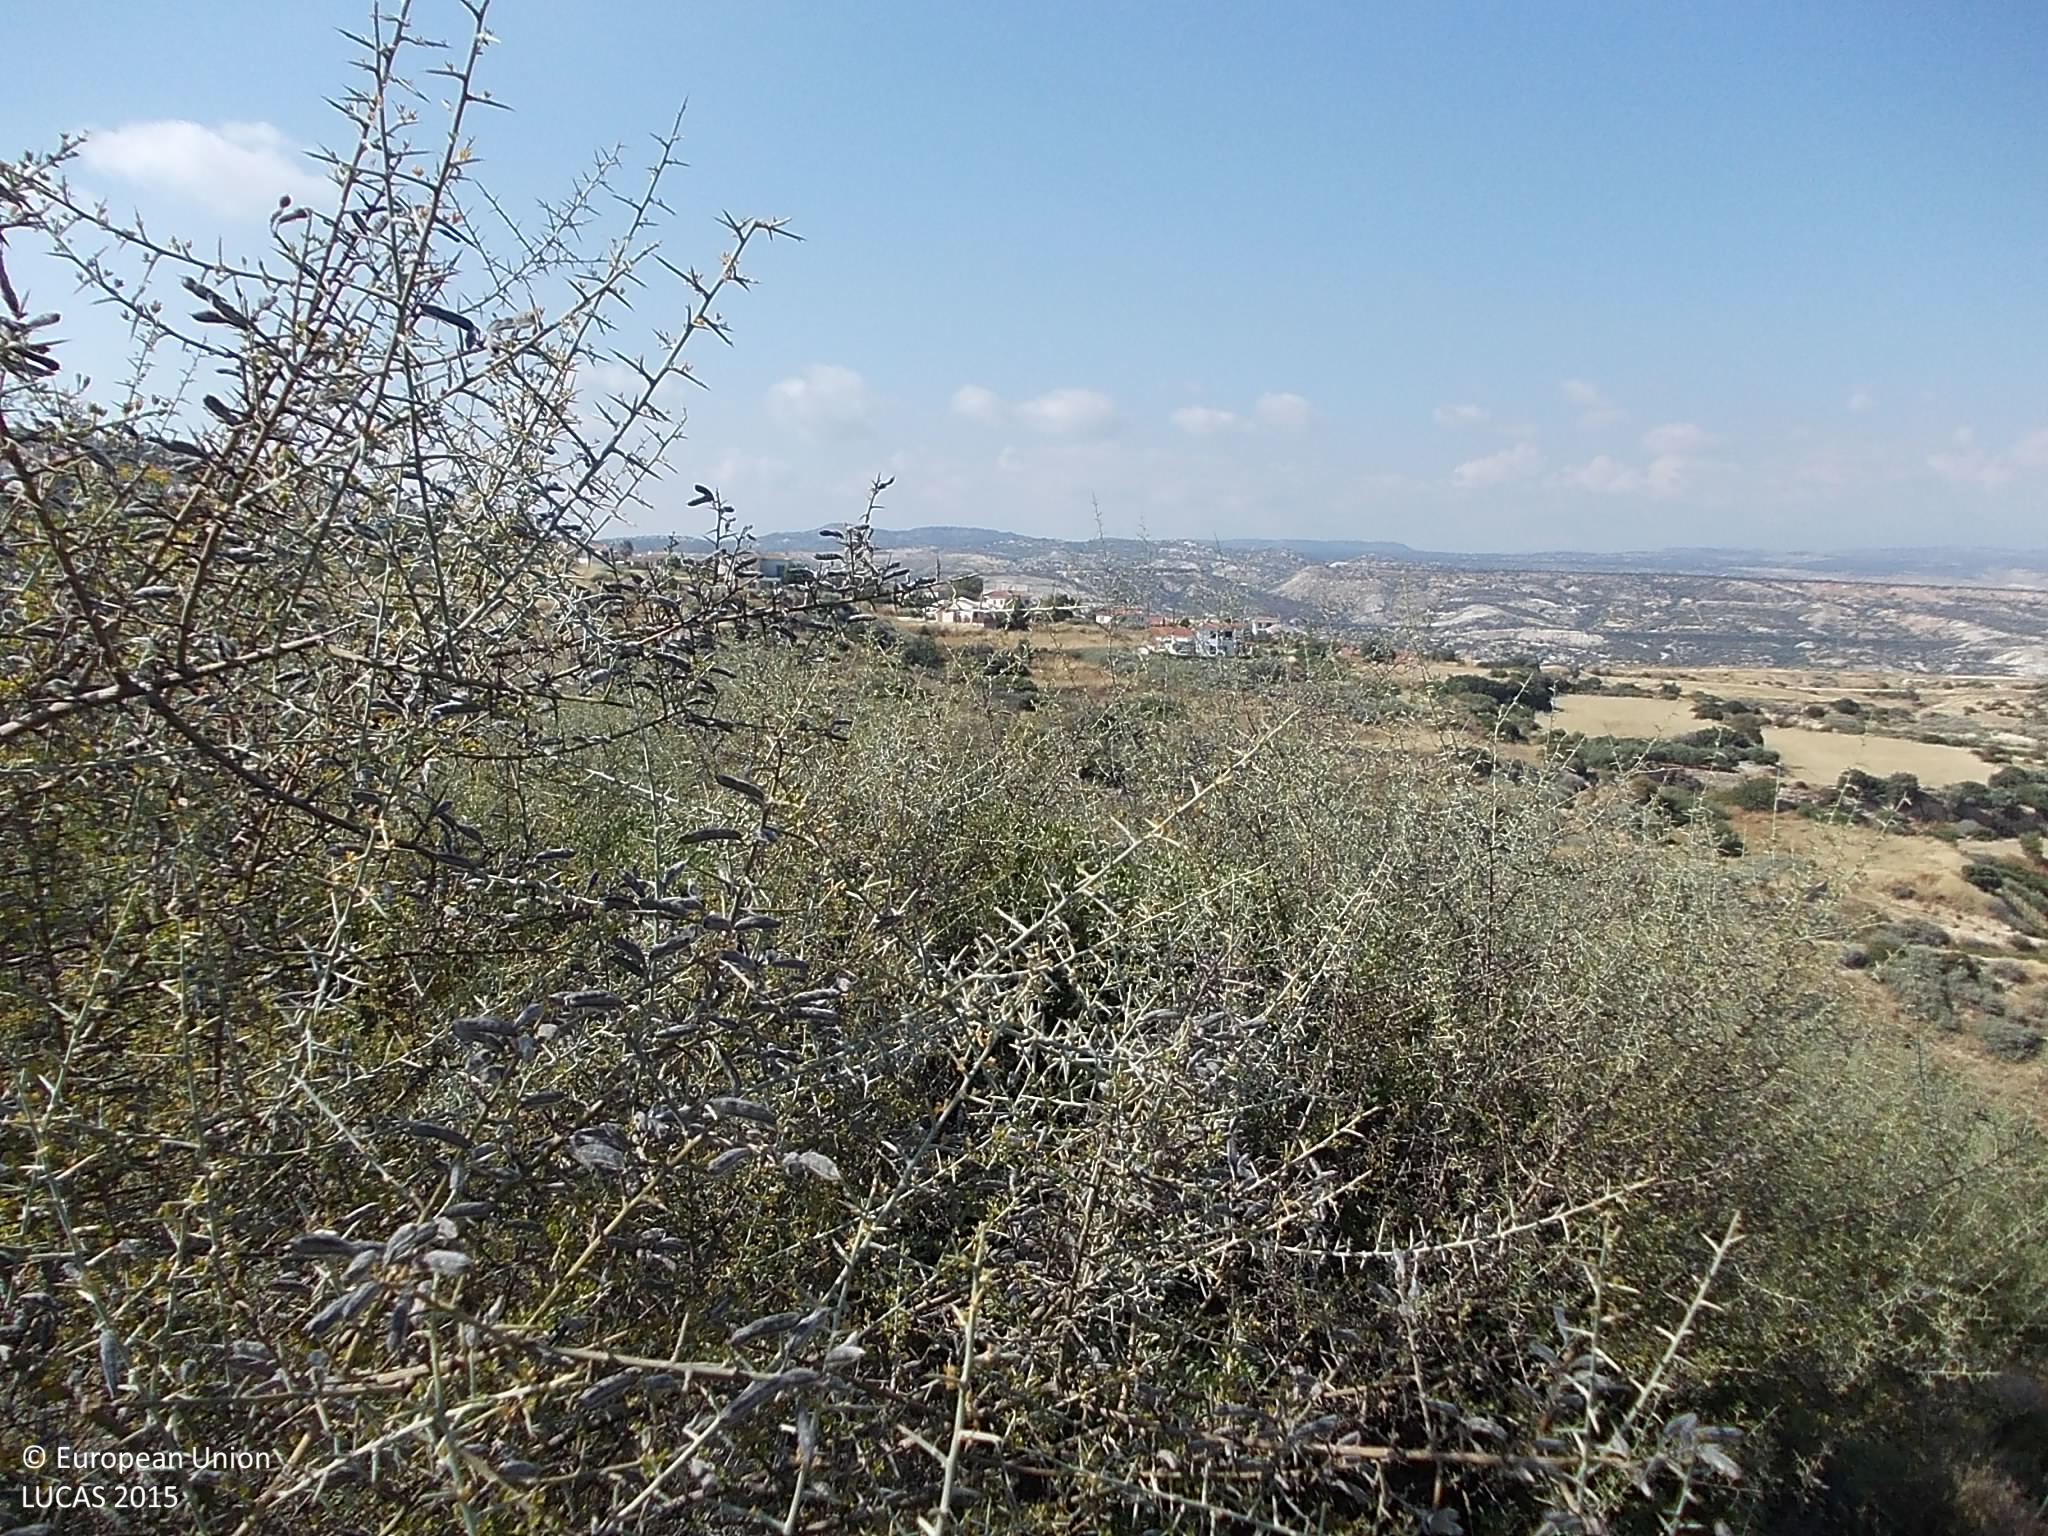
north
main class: Shrubland
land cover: Shrubland without tree cover
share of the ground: > 75 %
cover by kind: shrubs 95 %, herbaceous plants 5 %
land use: Semi-natural and natural areas not in use
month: June
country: CY
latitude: 34.6623
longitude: 32.7067
